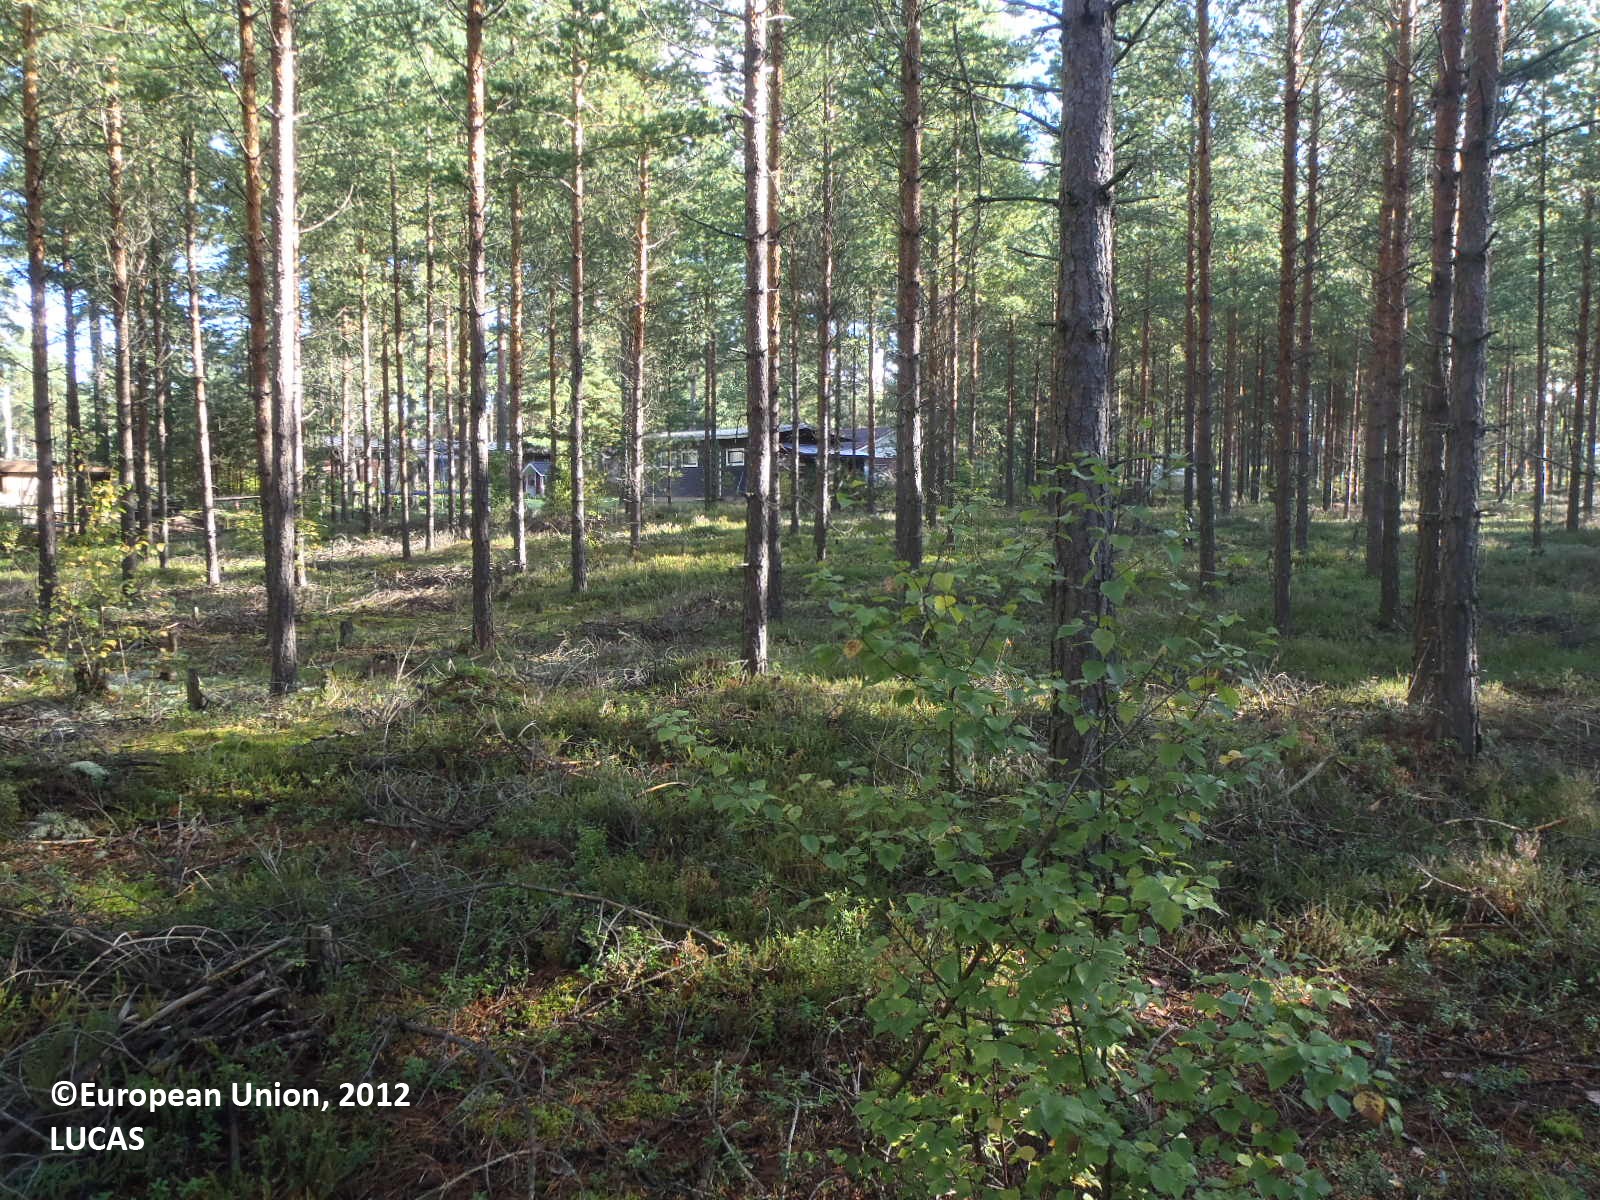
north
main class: Woodland
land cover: Pine dominated coniferous woodland
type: boreal forest
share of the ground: > 75 %
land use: Forestry
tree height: > 5 m
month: September
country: FI
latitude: 61.0746
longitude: 22.3901
